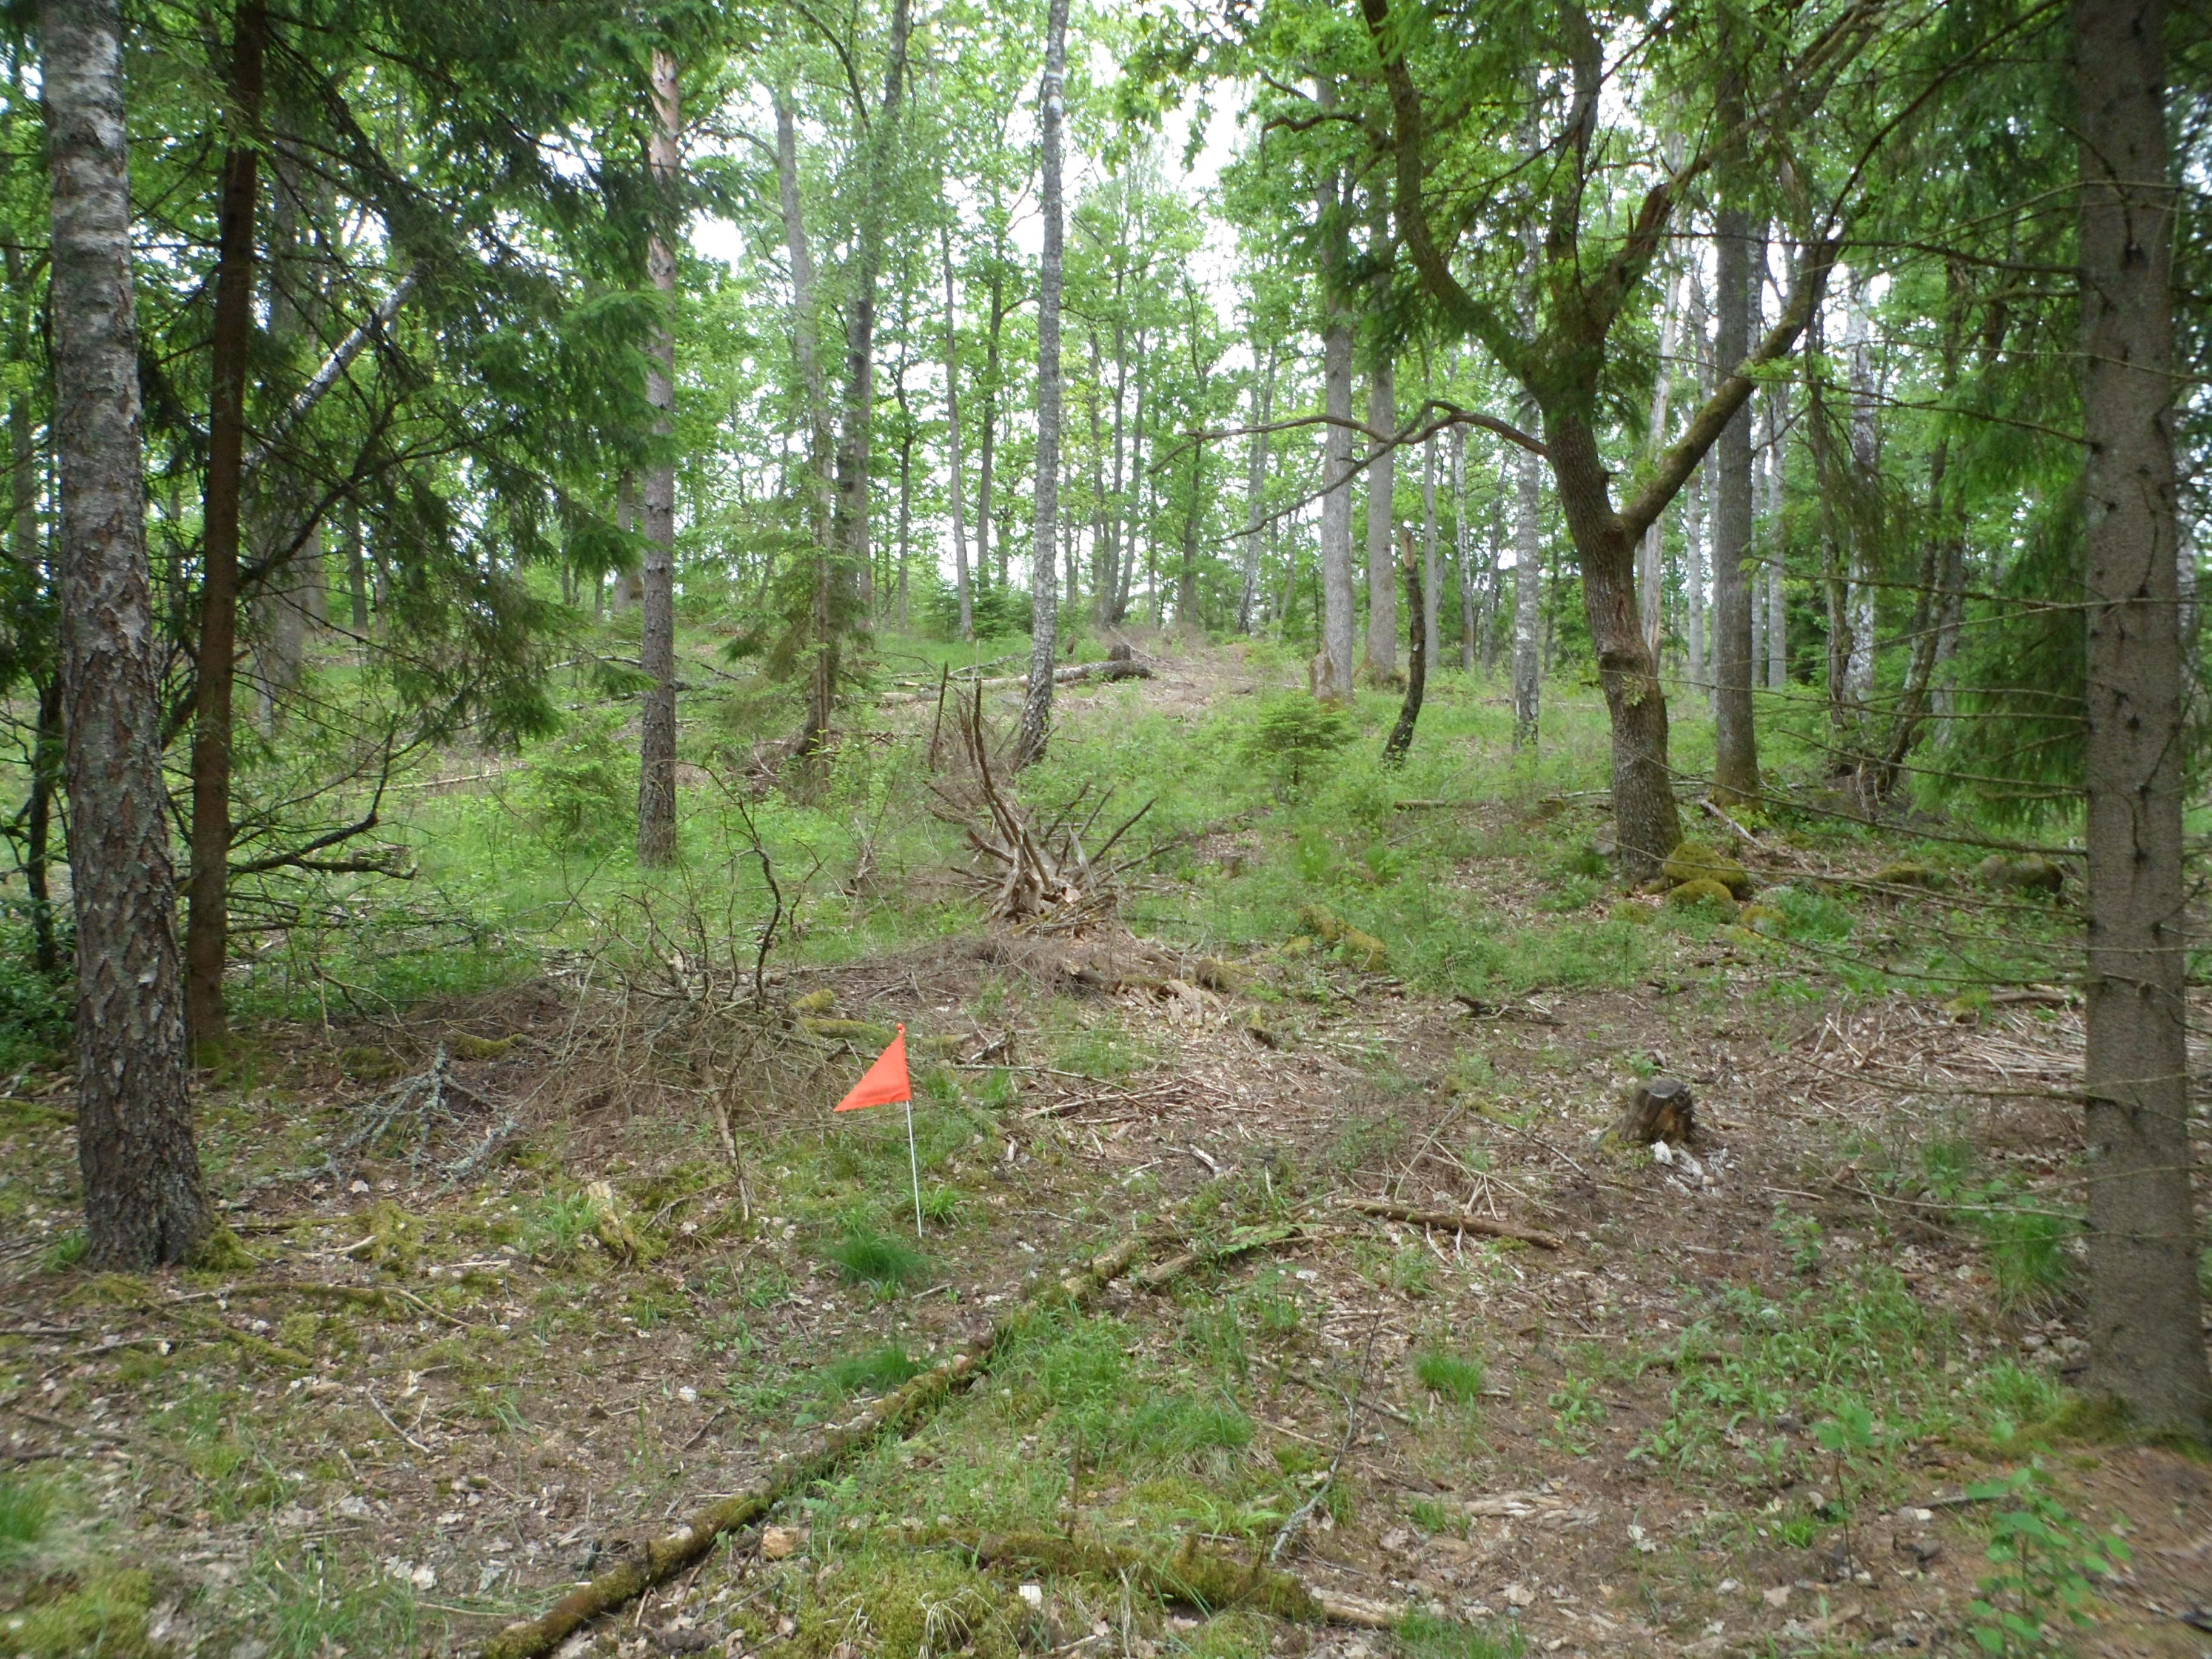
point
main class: Woodland
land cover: Spruce dominated mixed woodland
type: boreal forest
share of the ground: 50 - 75 %
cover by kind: coniferous forest trees 35 %, broadleaved forest trees 20 %, lichens and mosses 20 %, herbaceous plants 10 %, unconsolidated bare surface 10 %, shrubs 5 %
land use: Forestry
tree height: > 5 m
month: June
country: SE
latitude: 56.8078
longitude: 14.5993
